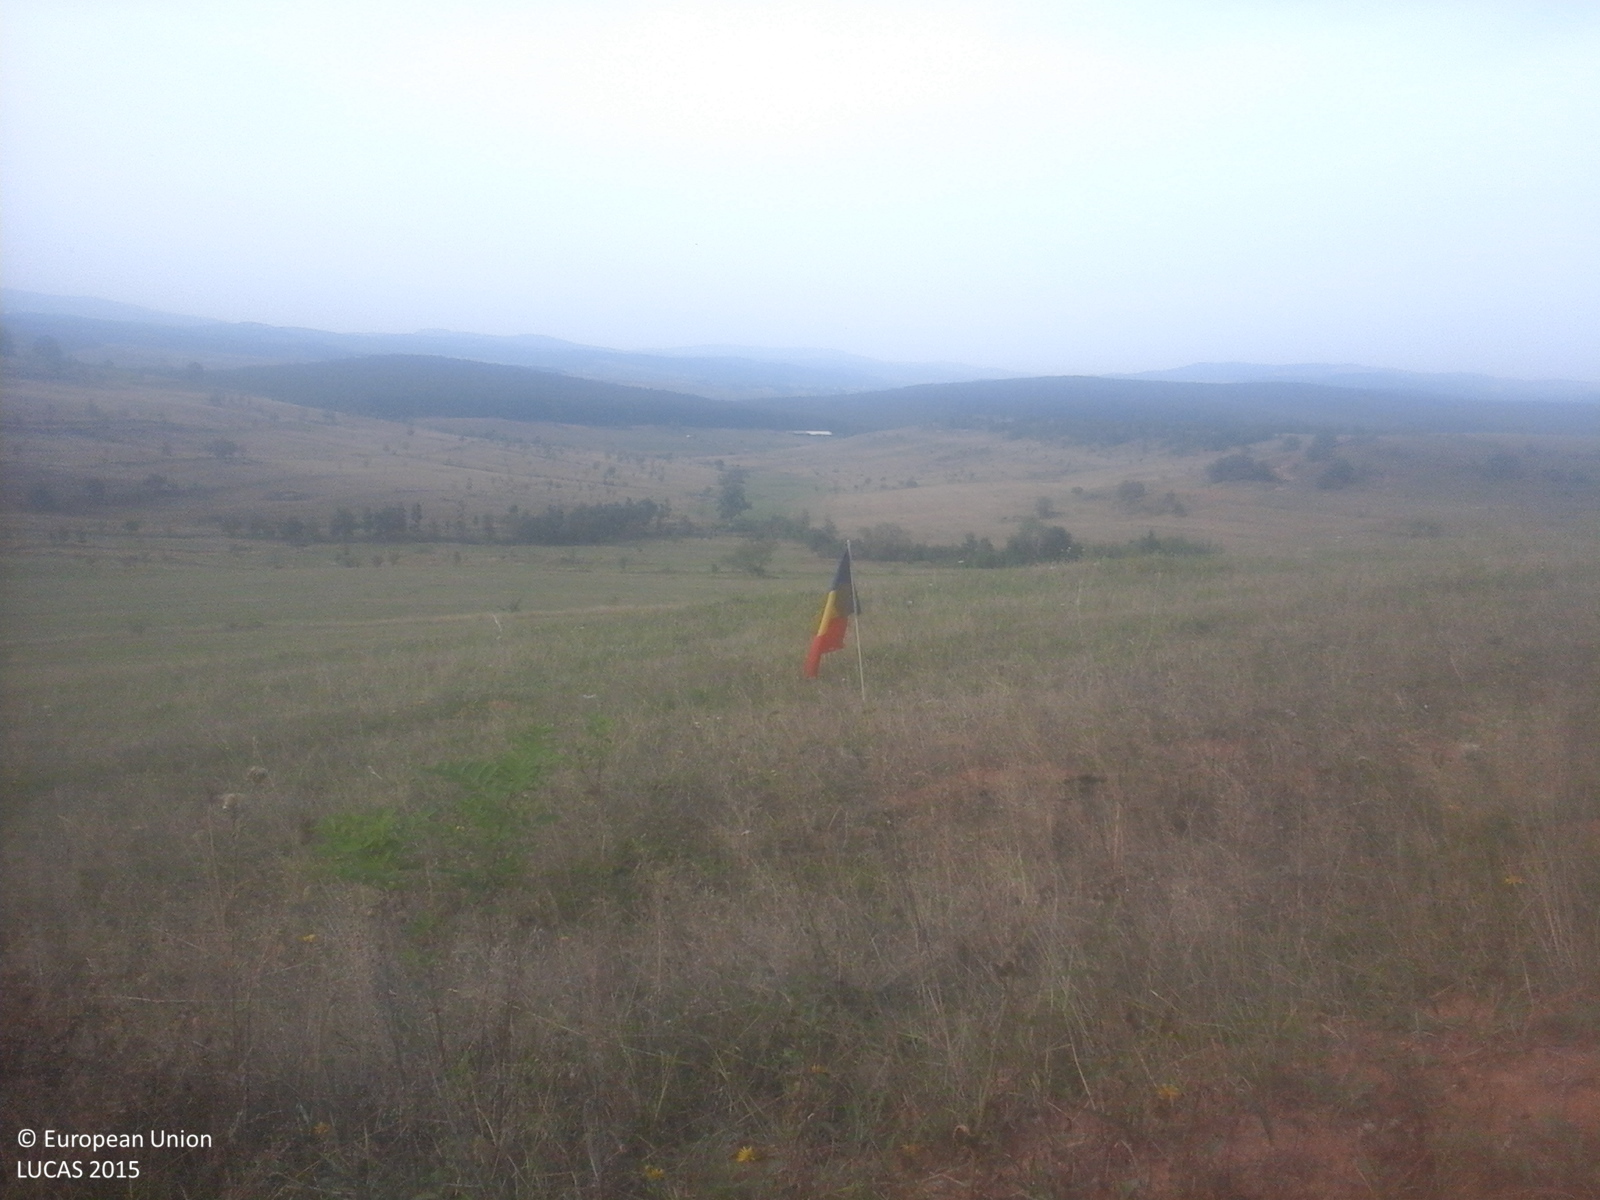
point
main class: Grassland
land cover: Grassland without tree/shrub cover
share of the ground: > 75 %
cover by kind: herbaceous plants 100 %
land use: Agriculture (excluding fallow land and kitchen gardens)
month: September
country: RO
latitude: 47.0473
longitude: 23.1621
